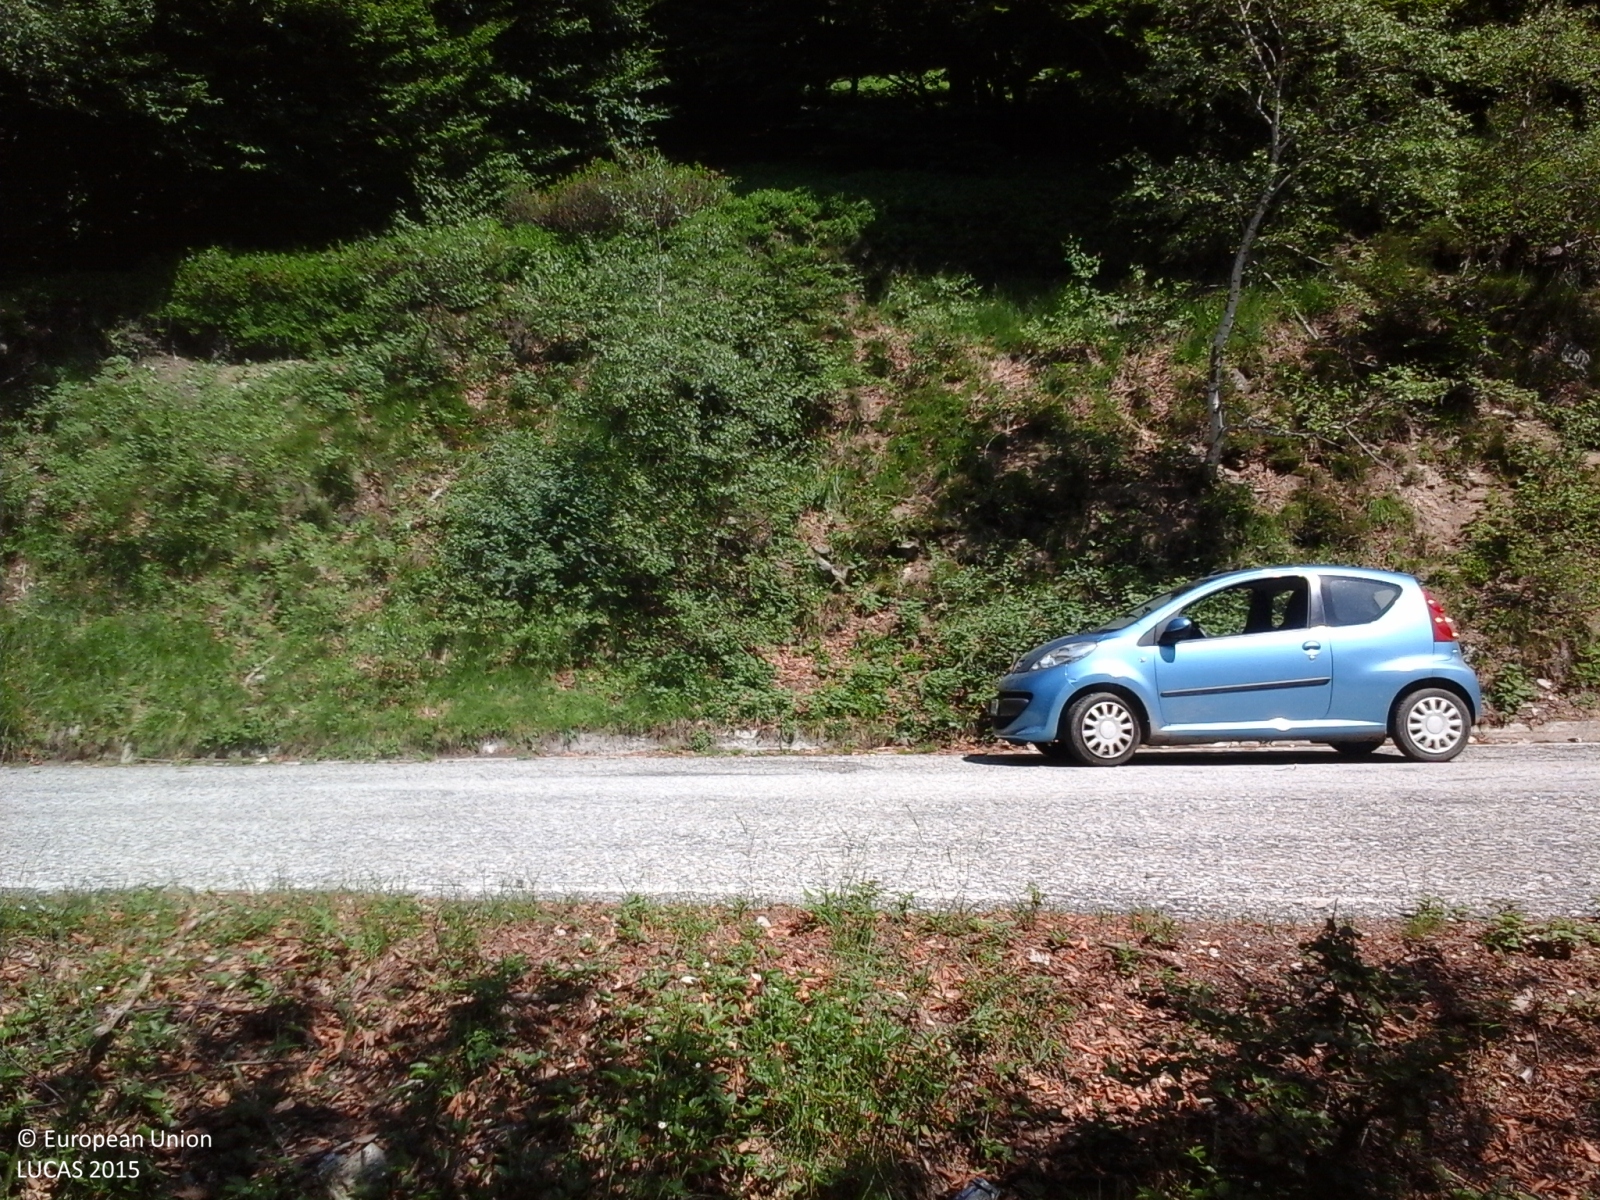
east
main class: Woodland
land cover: Broadleaved woodland
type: thermophilous deciduous forest
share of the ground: > 75 %
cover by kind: broadleaved forest trees 100 %
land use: Forestry
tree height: > 5 m
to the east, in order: Broadleaved woodland
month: June
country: IT
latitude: 46.0180
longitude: 8.6199
